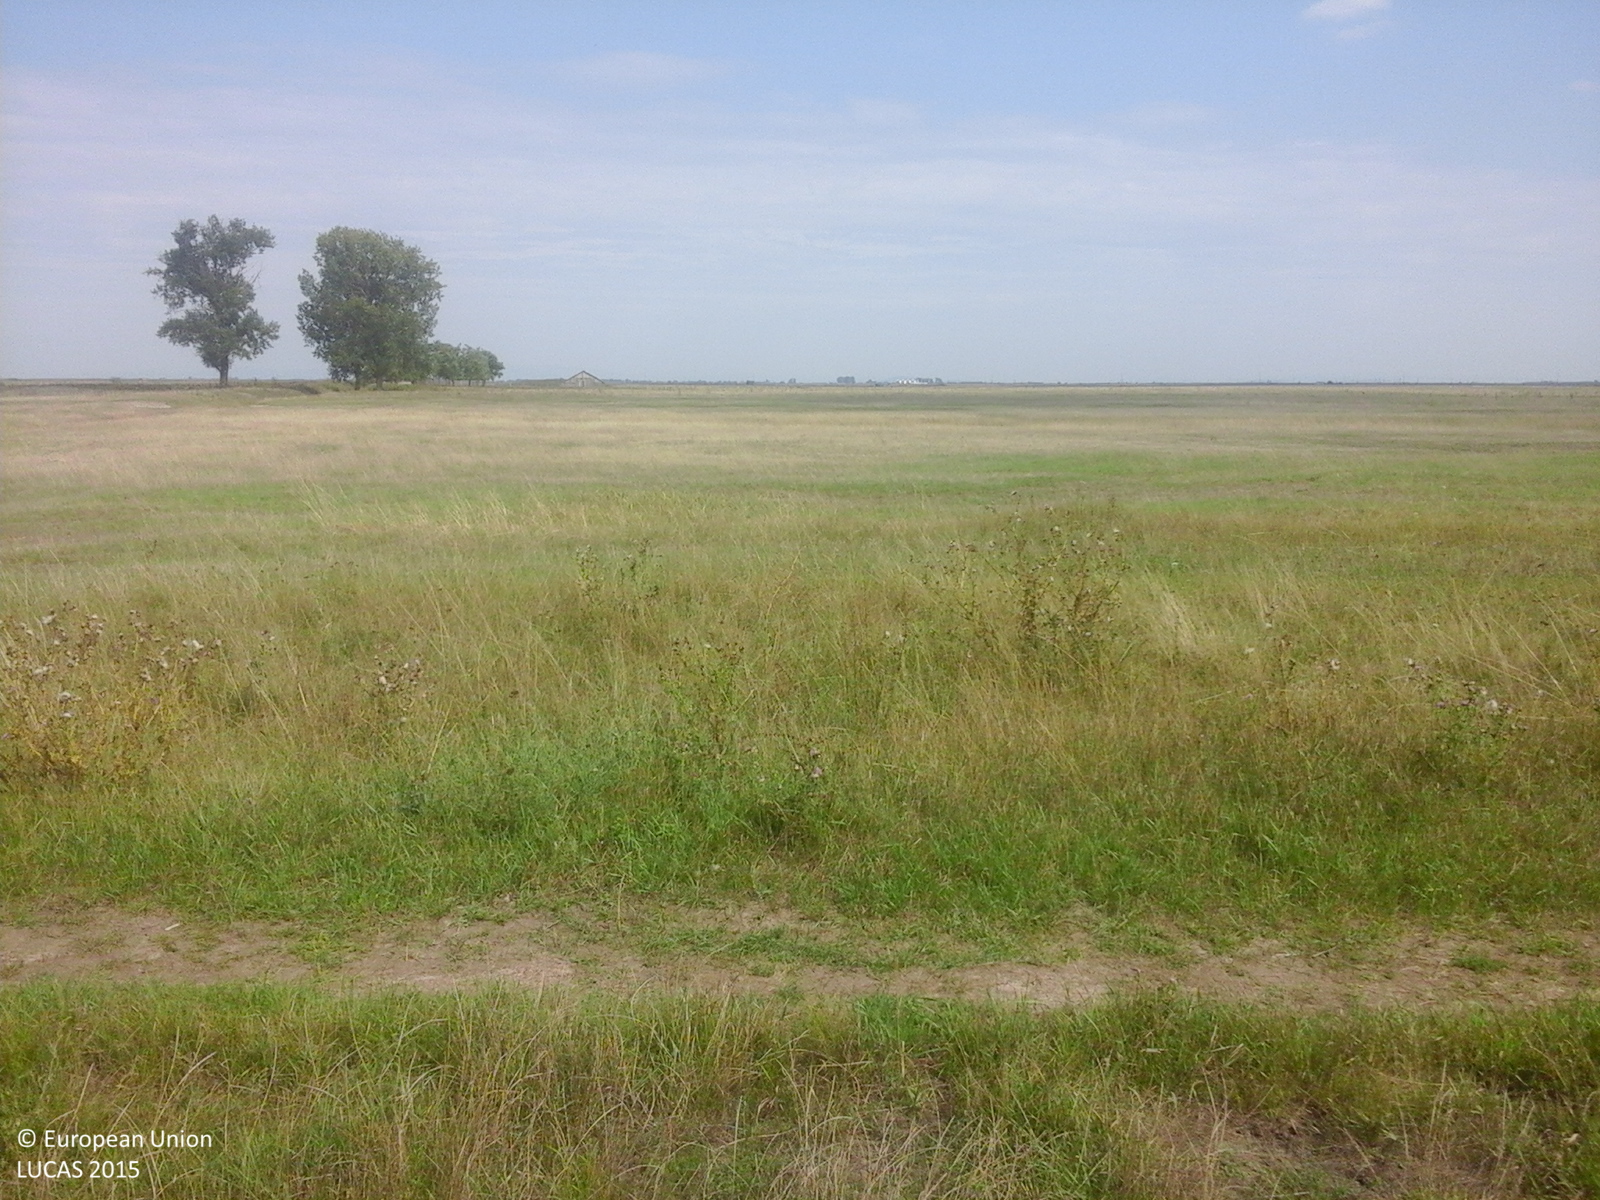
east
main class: Grassland
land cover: Spontaneously vegetated surfaces
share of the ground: > 75 %
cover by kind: herbaceous plants 100 %
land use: Fallow land
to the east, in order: Spontaneously vegetated surfaces; Tracks; Grass margins; Grassland without tree/shrub cover; Ditches and canals; Grassland without tree/shrub cover
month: August
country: RO
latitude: 46.4158
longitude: 21.3676
